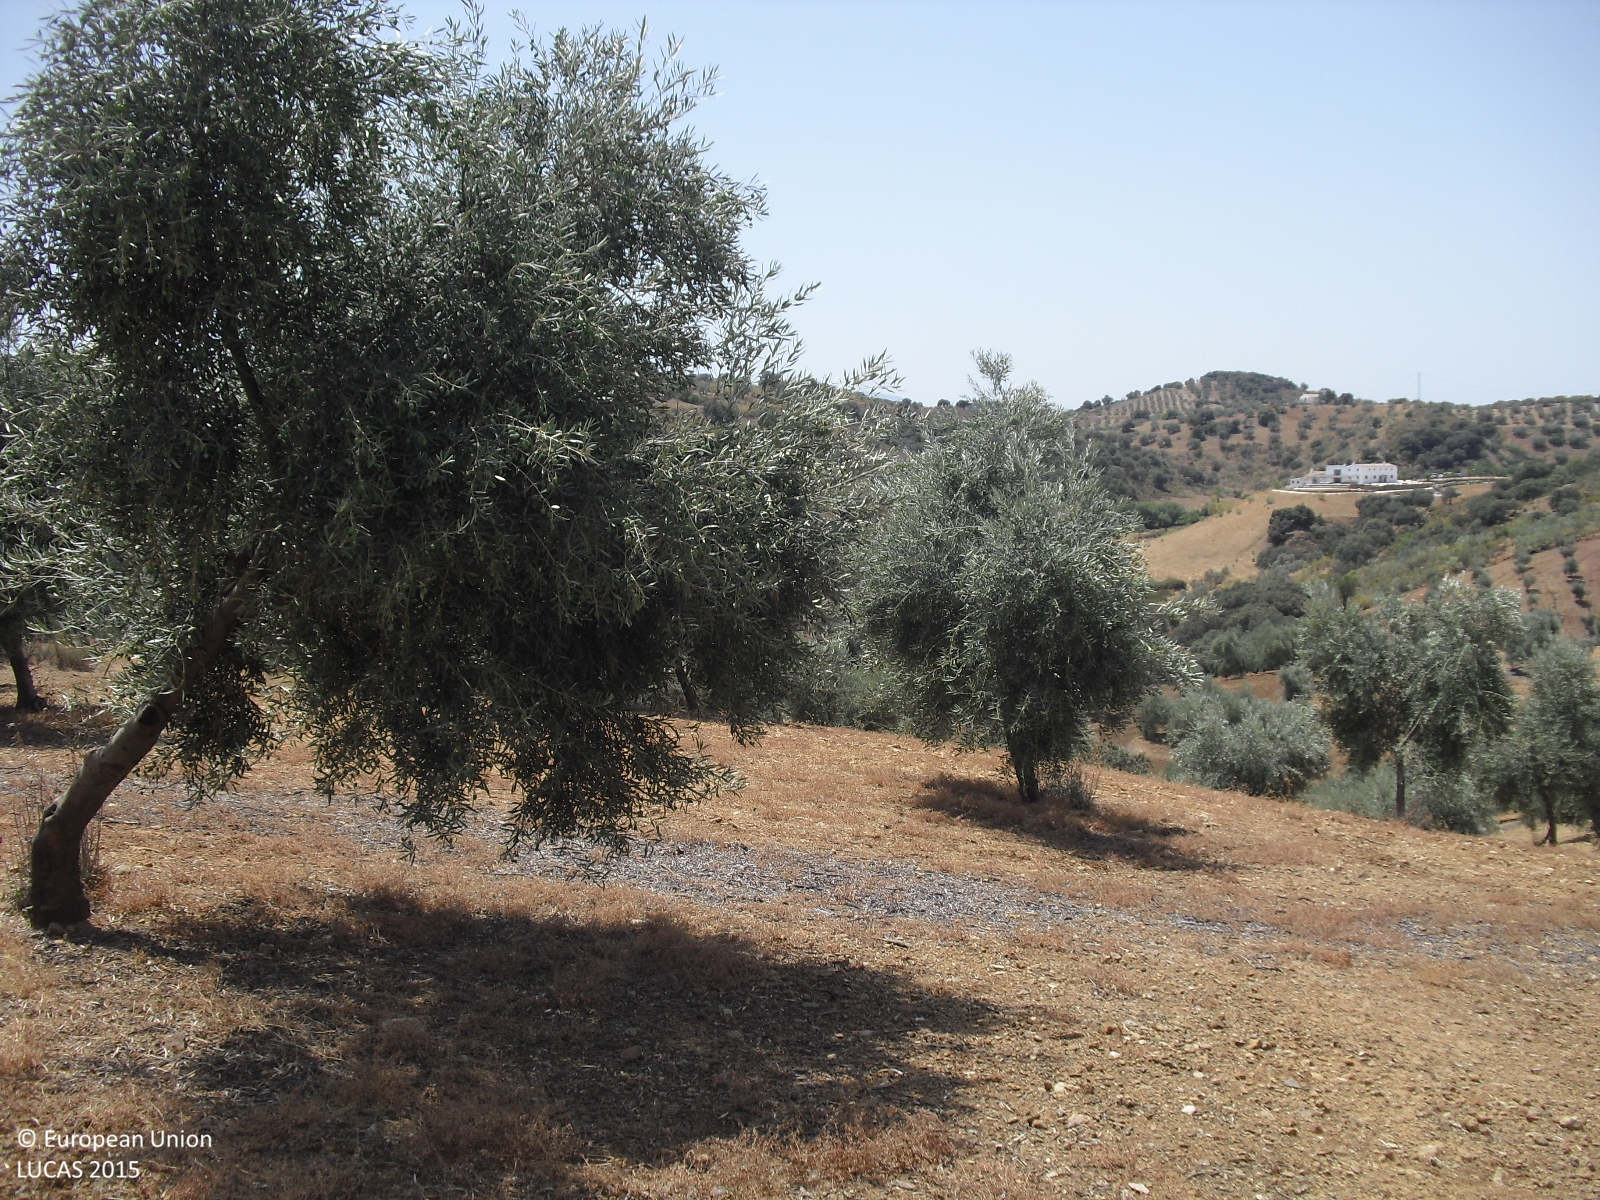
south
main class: Cropland
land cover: Olive groves
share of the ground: 10 - 25 %
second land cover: Other bare soil
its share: > 75 %
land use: Agriculture (excluding fallow land and kitchen gardens)
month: July
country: ES
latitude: 37.1738
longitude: -4.3114
